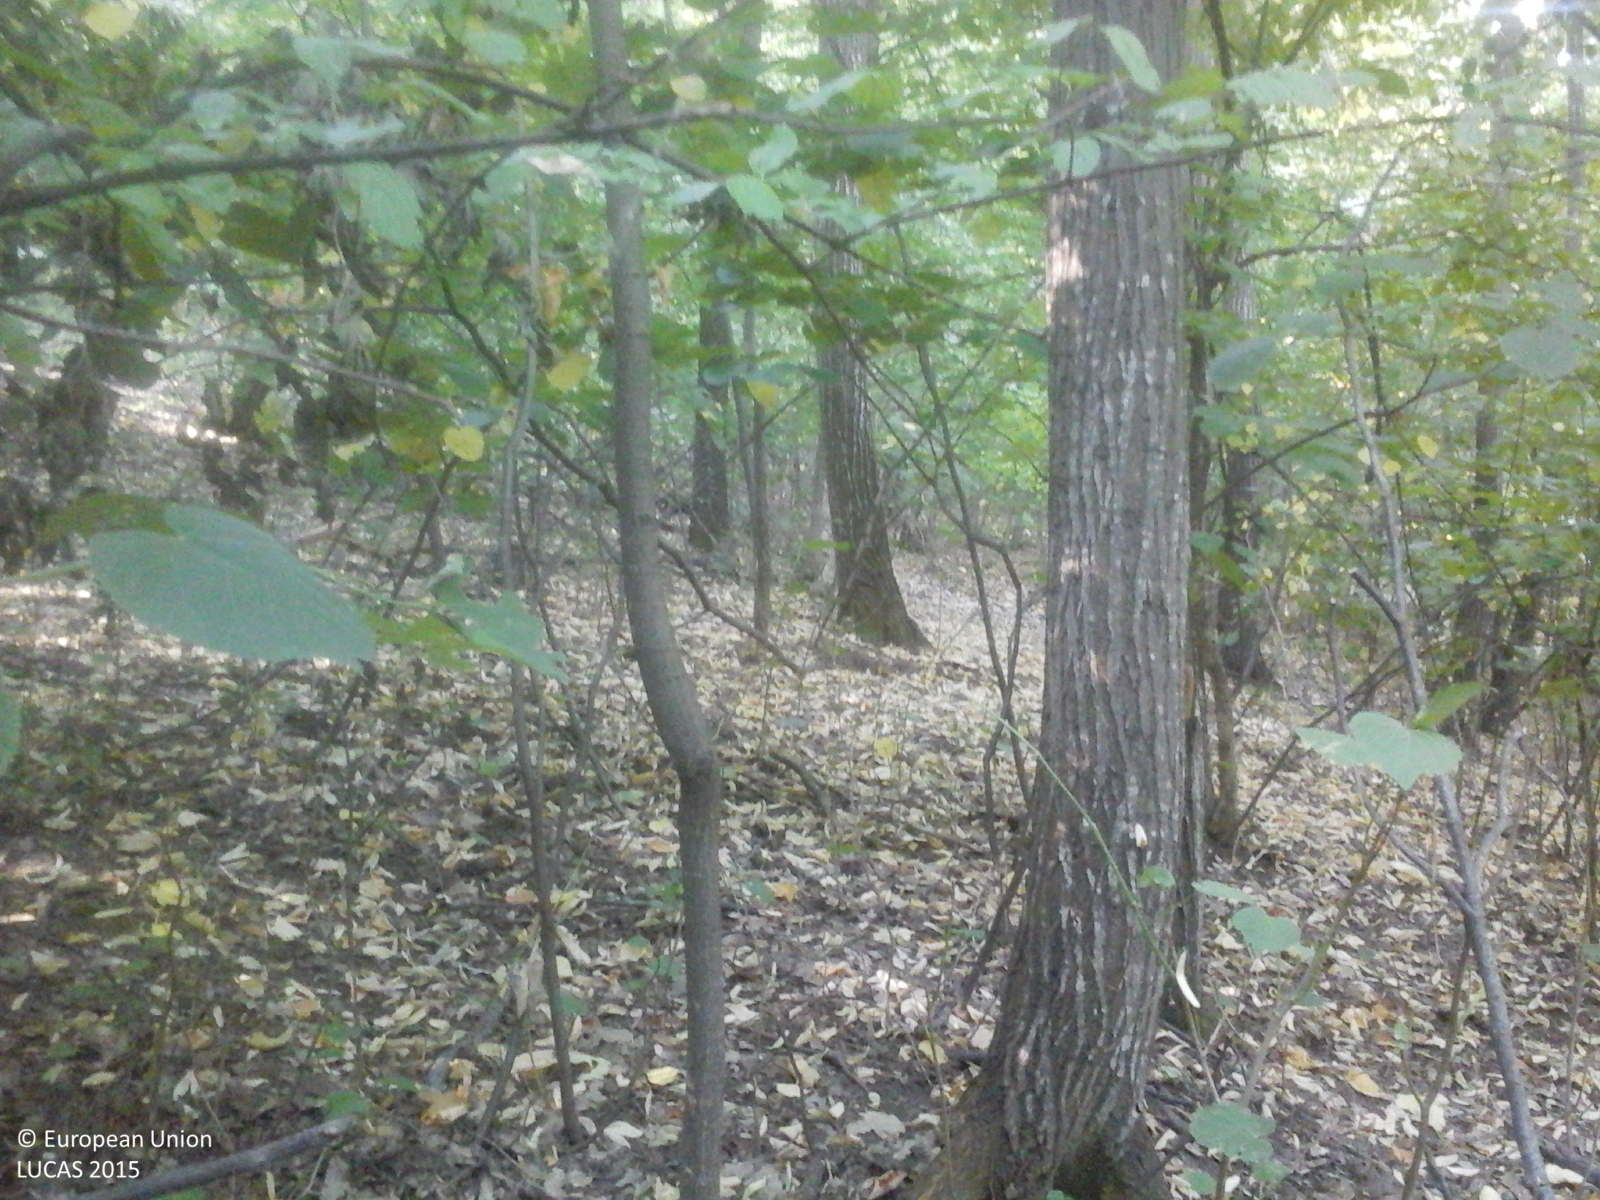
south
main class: Woodland
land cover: Broadleaved woodland
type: mesophytic deciduous forest
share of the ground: > 75 %
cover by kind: broadleaved forest trees 100 %
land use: Forestry
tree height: > 5 m
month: July
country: RO
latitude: 46.2918
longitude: 27.8384
